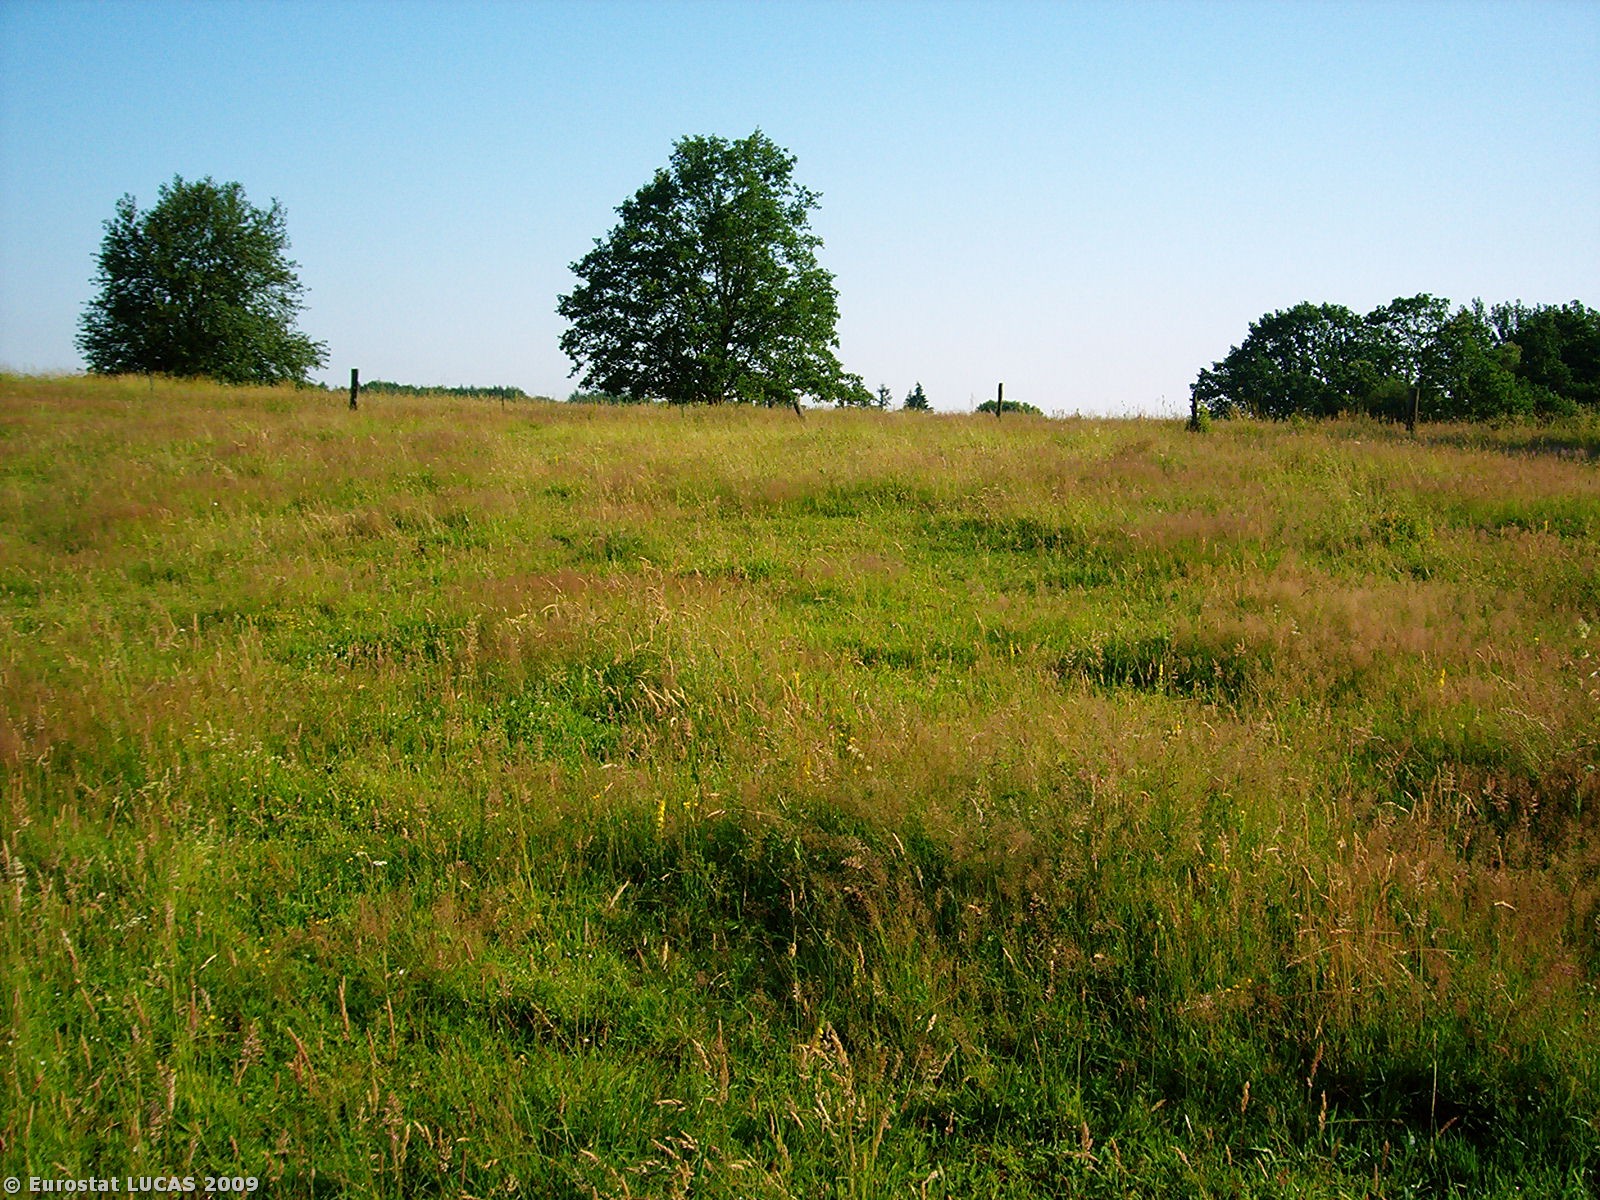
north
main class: Grassland
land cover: Grassland without tree/shrub cover
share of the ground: > 75 %
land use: Agriculture (excluding fallow land and kitchen gardens)
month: July
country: PL
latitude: 53.3855
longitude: 15.4911
